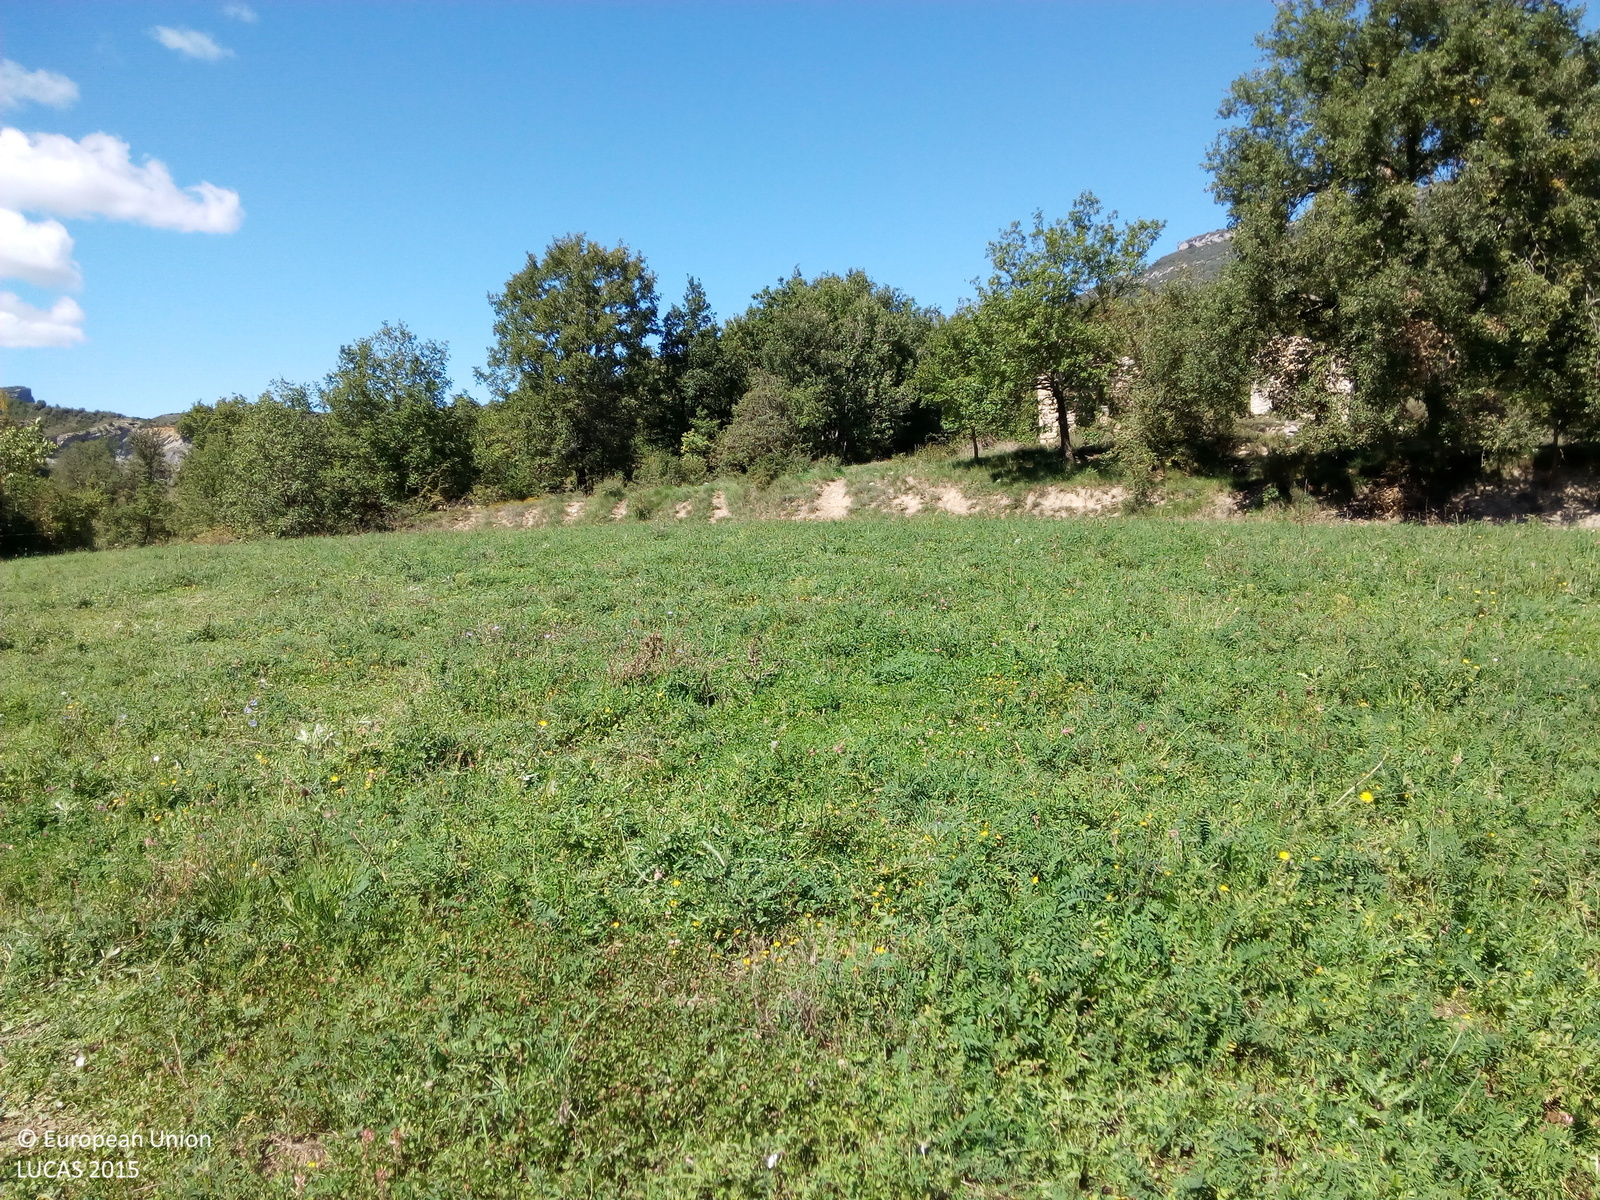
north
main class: Grassland
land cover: Grassland without tree/shrub cover
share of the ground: > 75 %
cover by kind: herbaceous plants 100 %
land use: Agriculture (excluding fallow land and kitchen gardens)
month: September
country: ES
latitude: 42.3162
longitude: 0.5058
